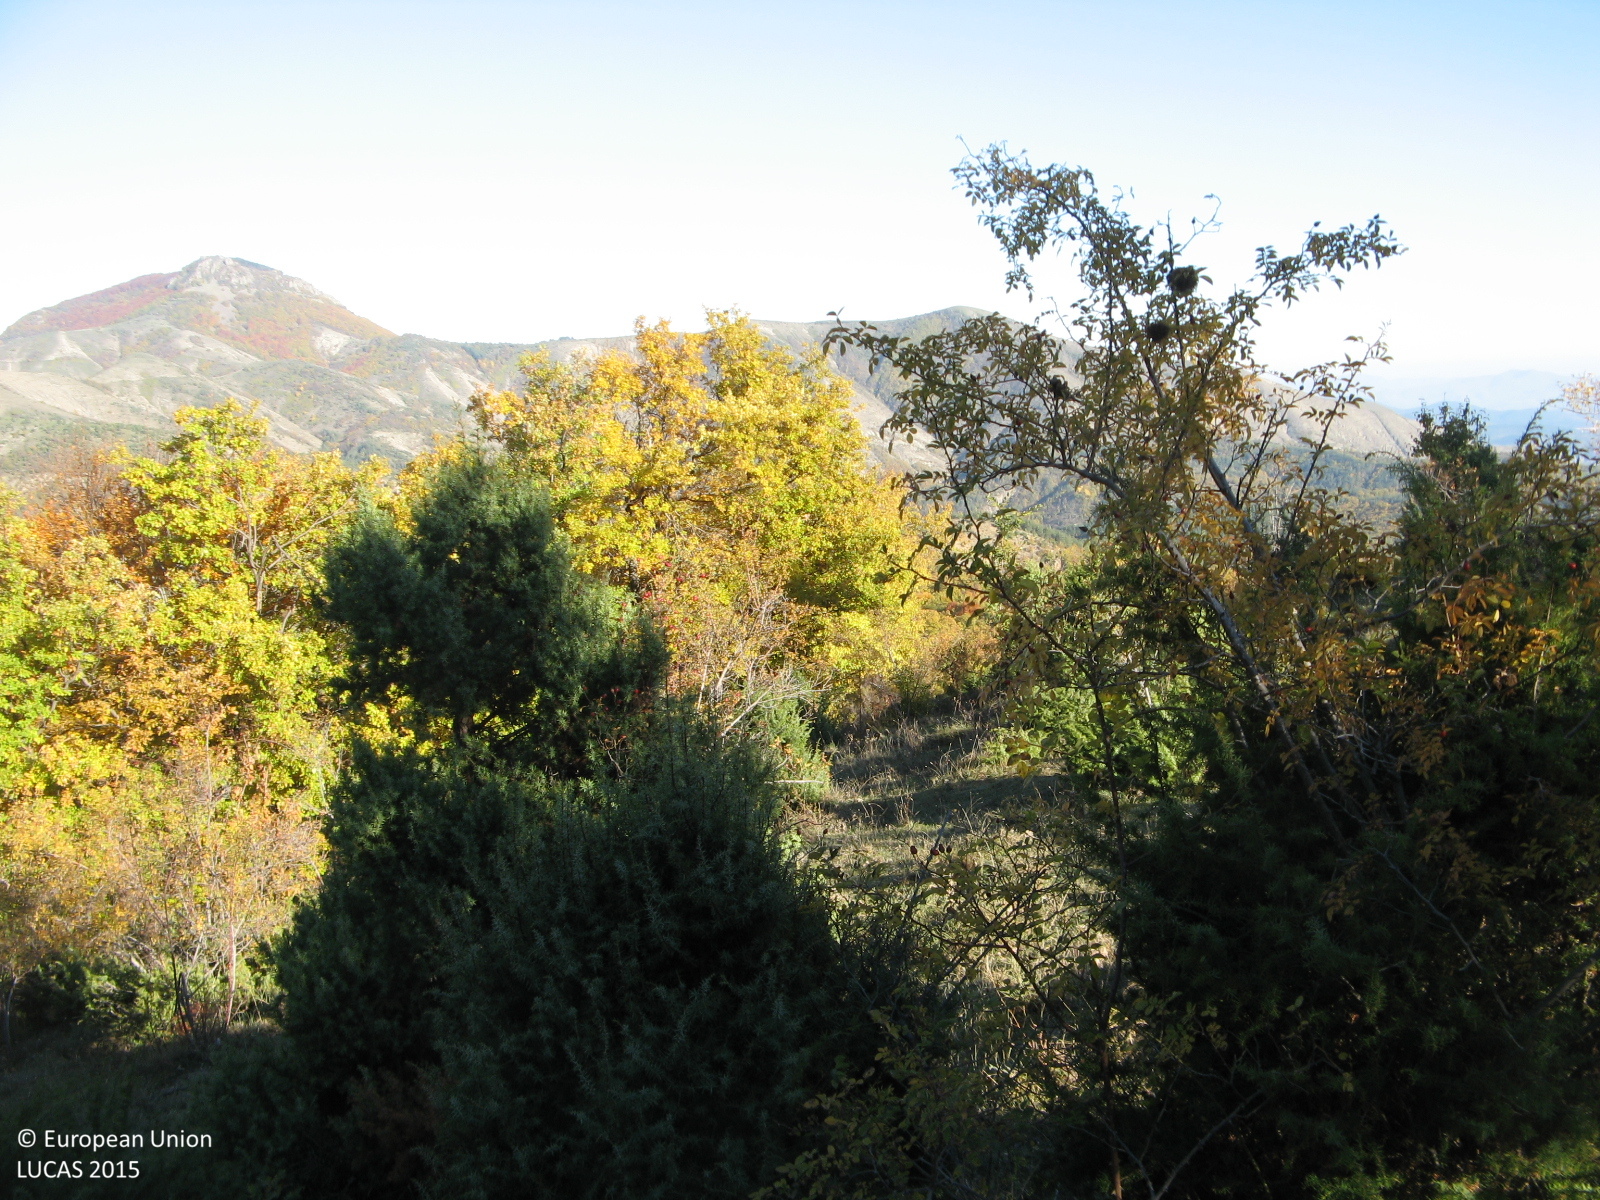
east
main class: Woodland
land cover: Pine dominated mixed woodland
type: hemiboreal forest and nemoral coniferous forest and mixed broadleaved-coniferous forest
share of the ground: > 75 %
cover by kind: coniferous forest trees 75 %, broadleaved forest trees 25 %
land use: Semi-natural and natural areas not in use
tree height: > 5 m
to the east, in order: Pine dominated mixed woodland; Grassland with sparse tree/shrub cover; Pine dominated mixed woodland; Broadleaved woodland; Grassland with sparse tree/shrub cover; Broadleaved woodland
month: November
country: BG
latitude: 41.7107
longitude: 25.1365
